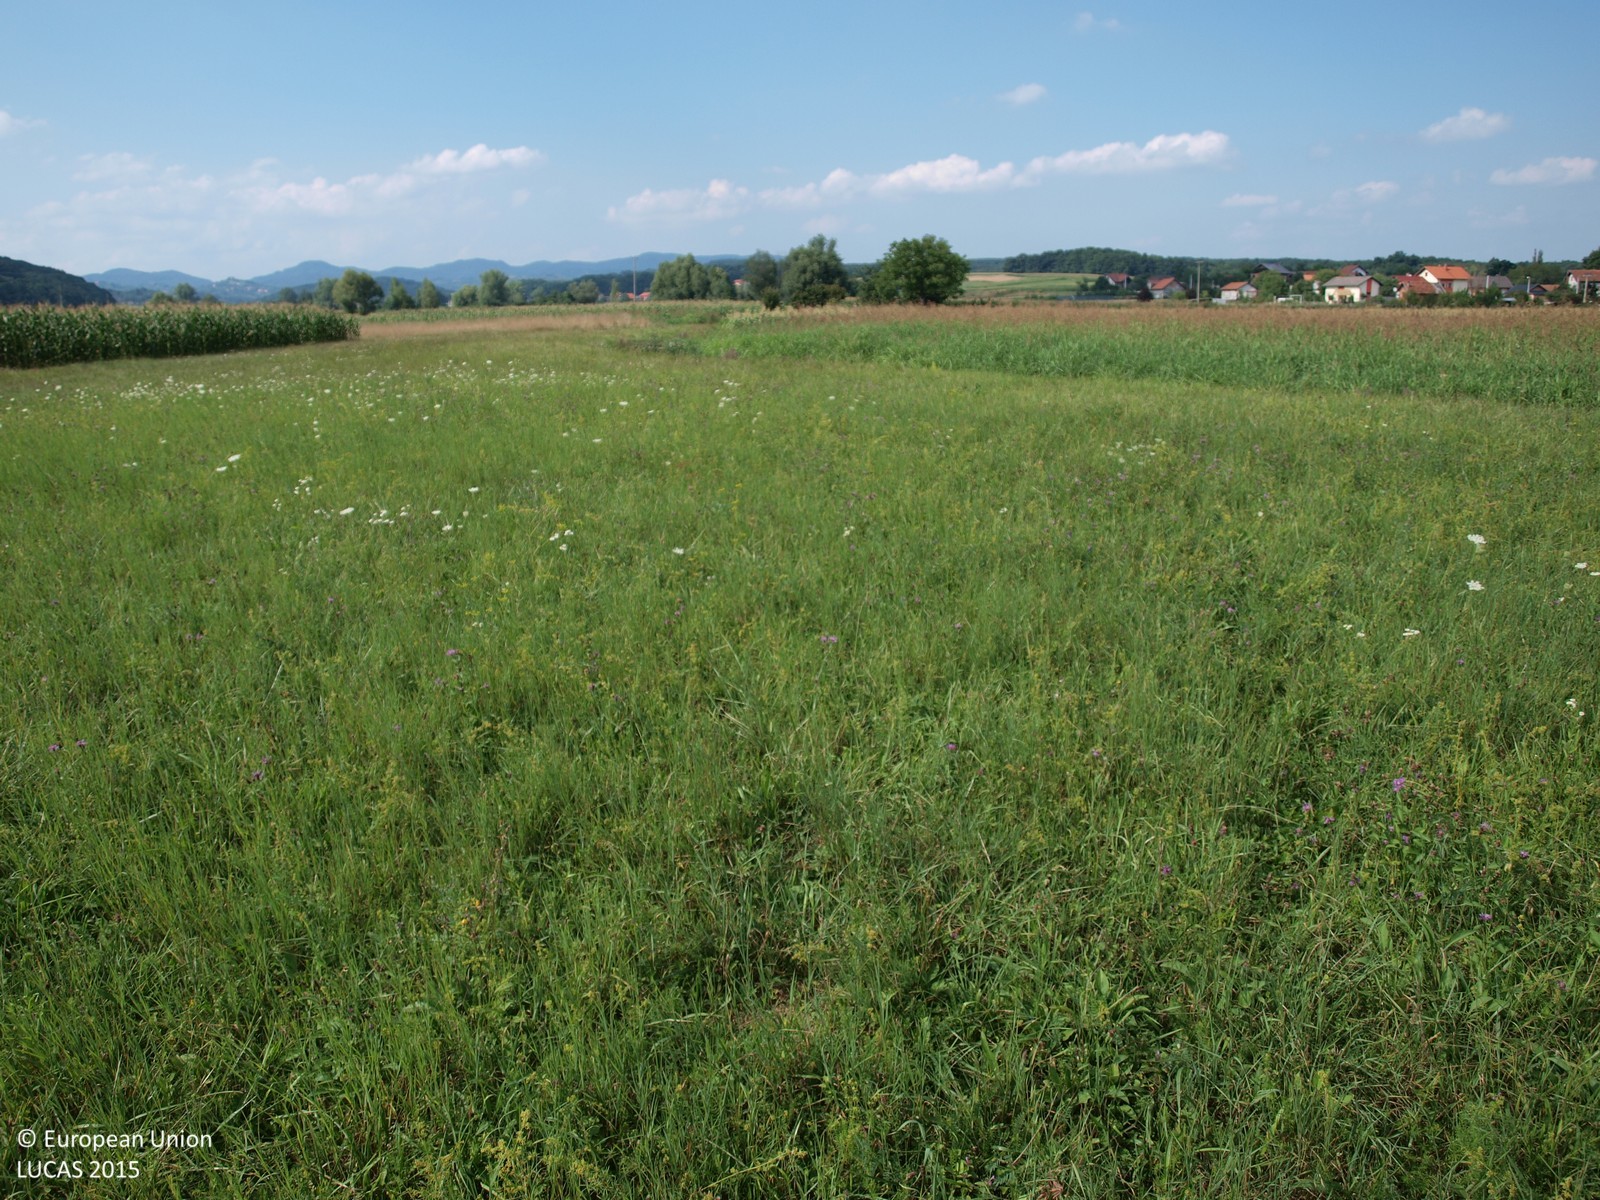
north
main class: Grassland
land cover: Grassland without tree/shrub cover
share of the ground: > 75 %
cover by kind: herbaceous plants 100 %
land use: Agriculture (excluding fallow land and kitchen gardens)
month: August
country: HR
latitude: 45.8840
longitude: 16.1707
